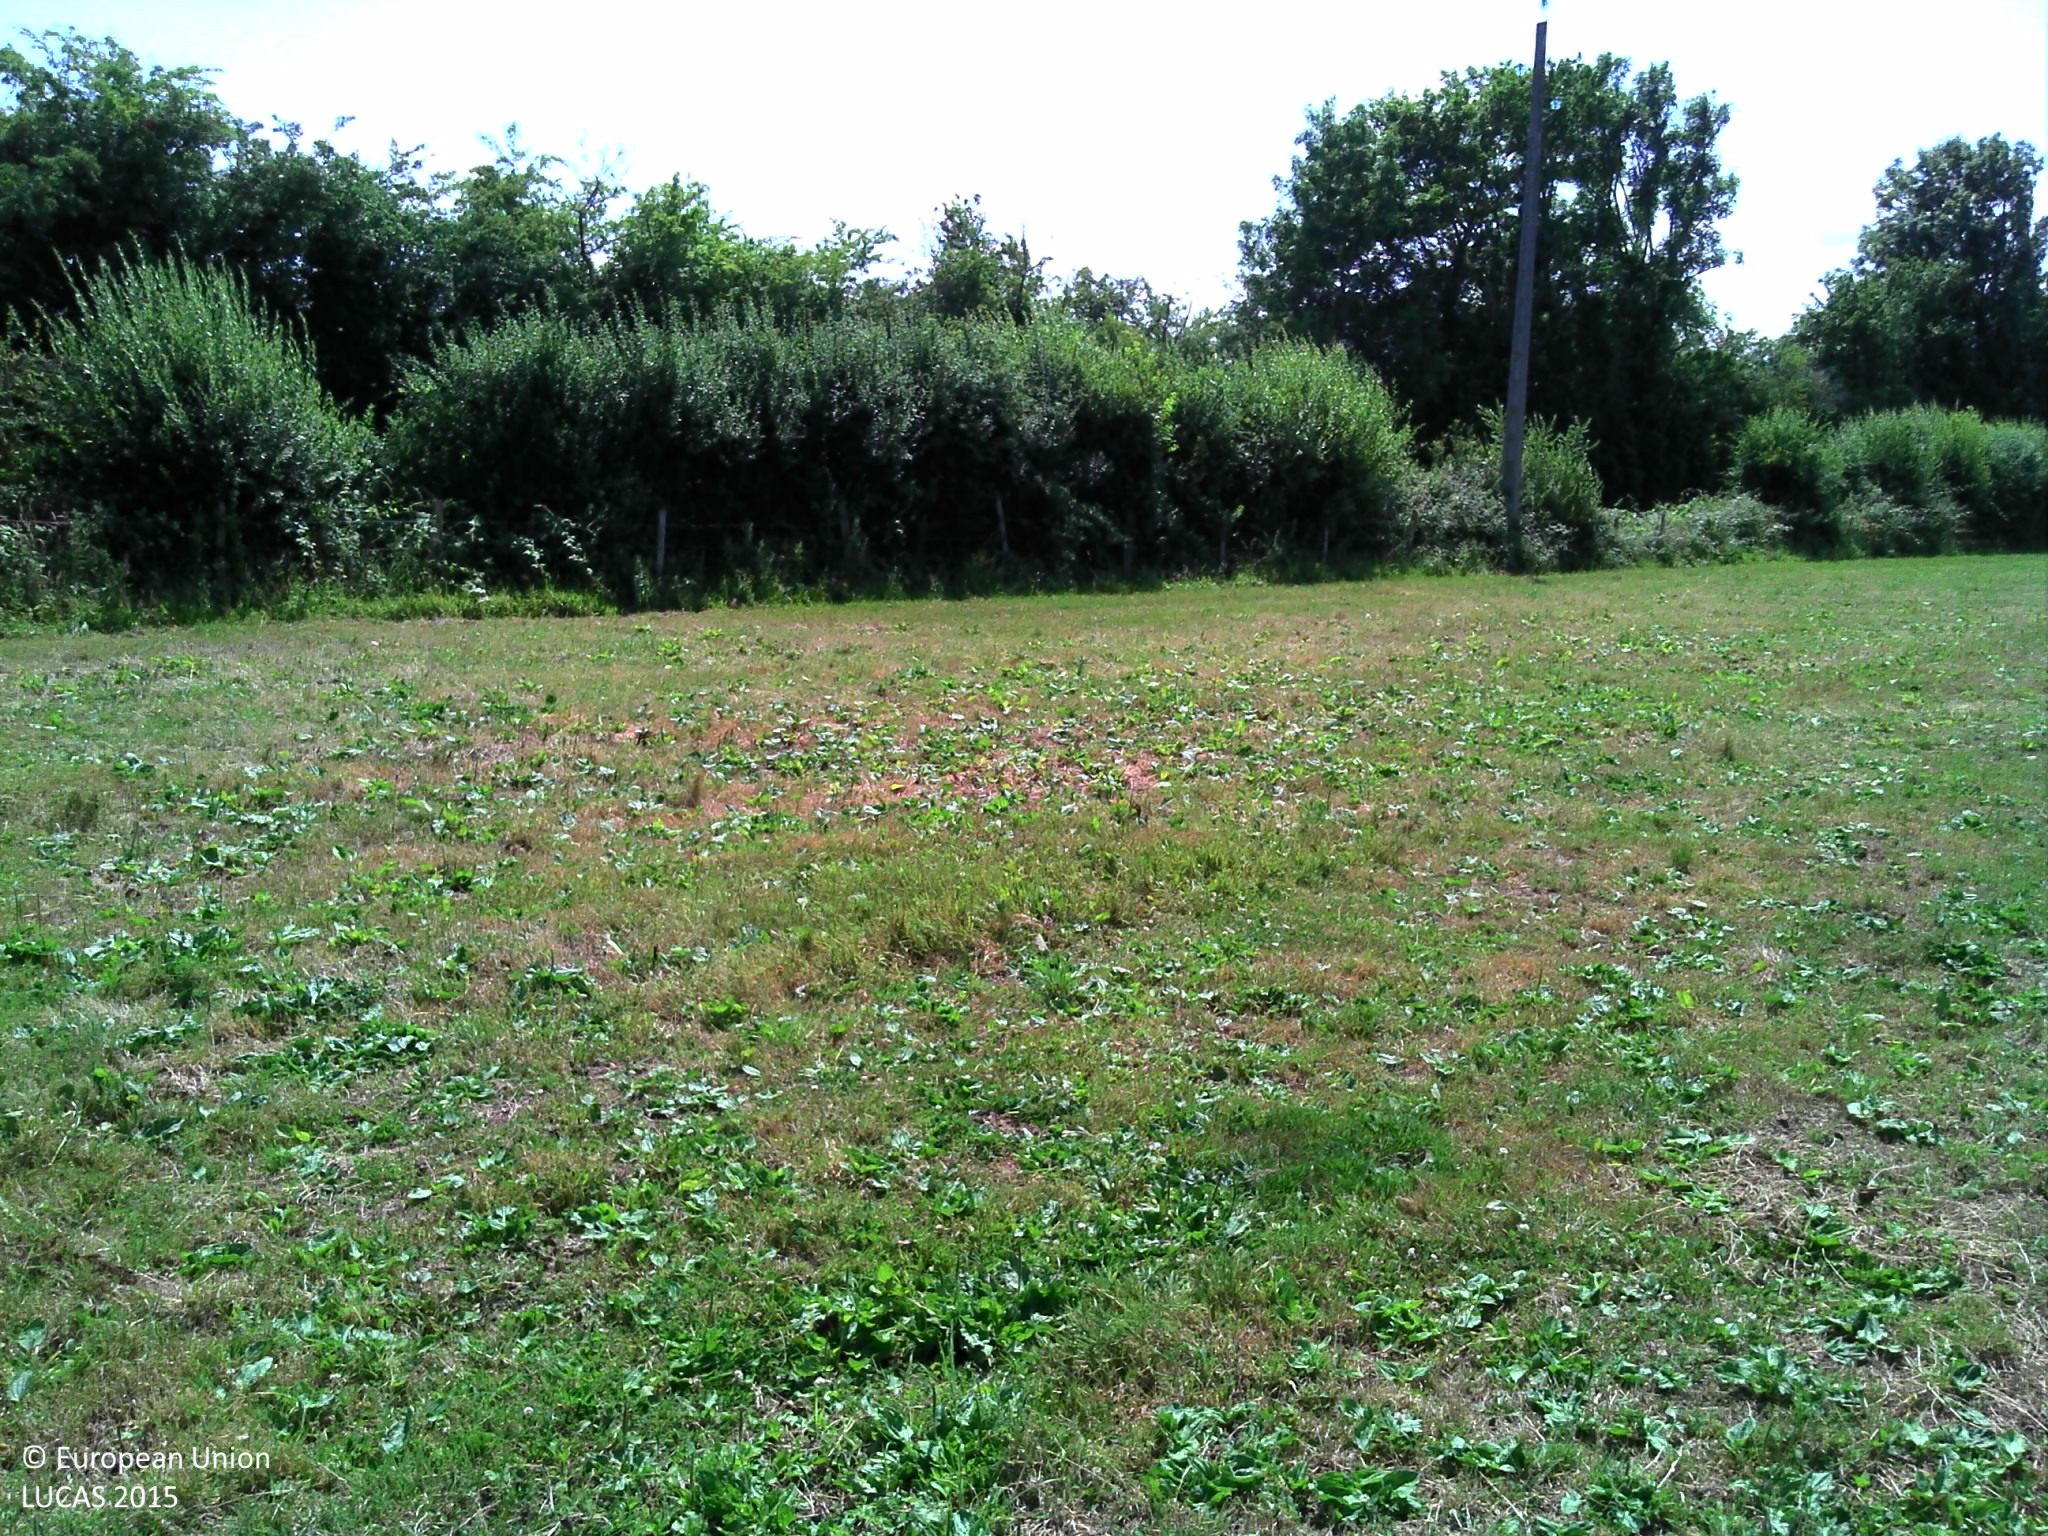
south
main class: Grassland
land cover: Grassland without tree/shrub cover
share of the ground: > 75 %
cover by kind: herbaceous plants 100 %
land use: Agriculture (excluding fallow land and kitchen gardens)
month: July
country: FR
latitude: 49.0898
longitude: -0.0136
